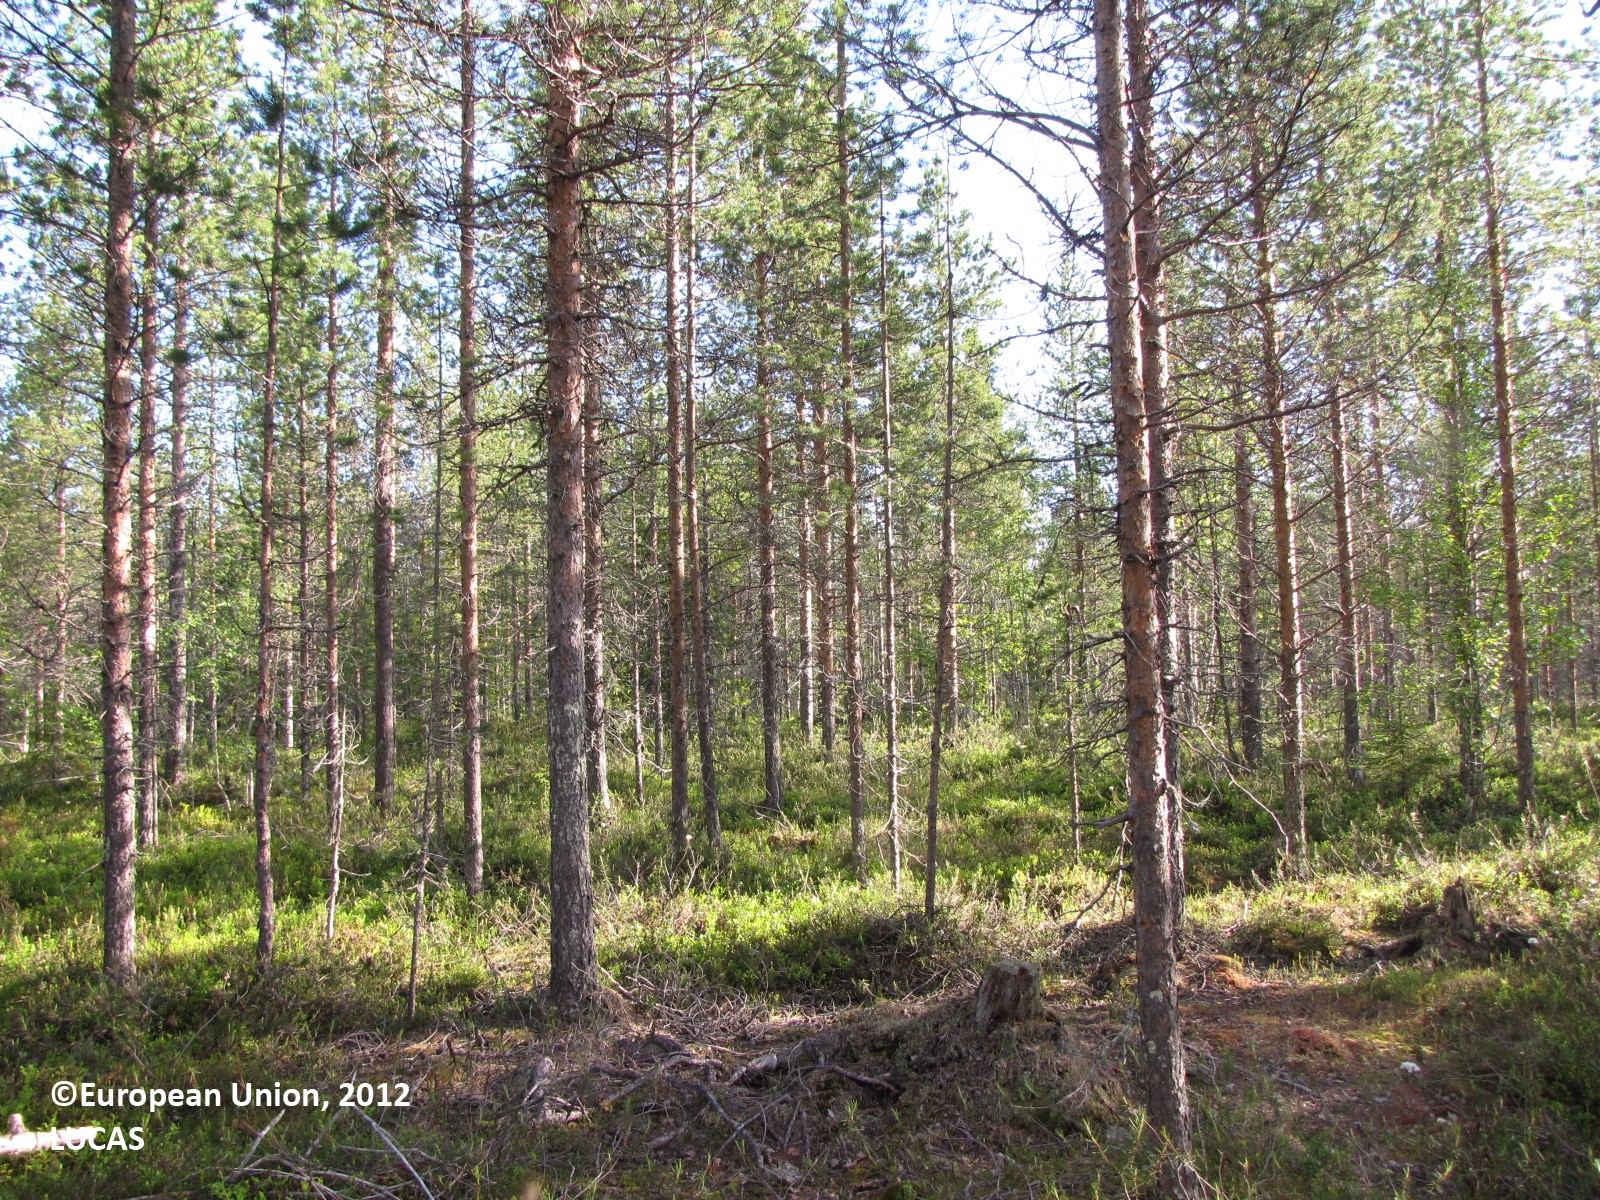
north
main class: Woodland
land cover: Pine dominated coniferous woodland
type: boreal forest
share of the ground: 50 - 75 %
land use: Forestry
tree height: > 5 m
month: June
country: FI
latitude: 66.2496
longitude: 24.3527
